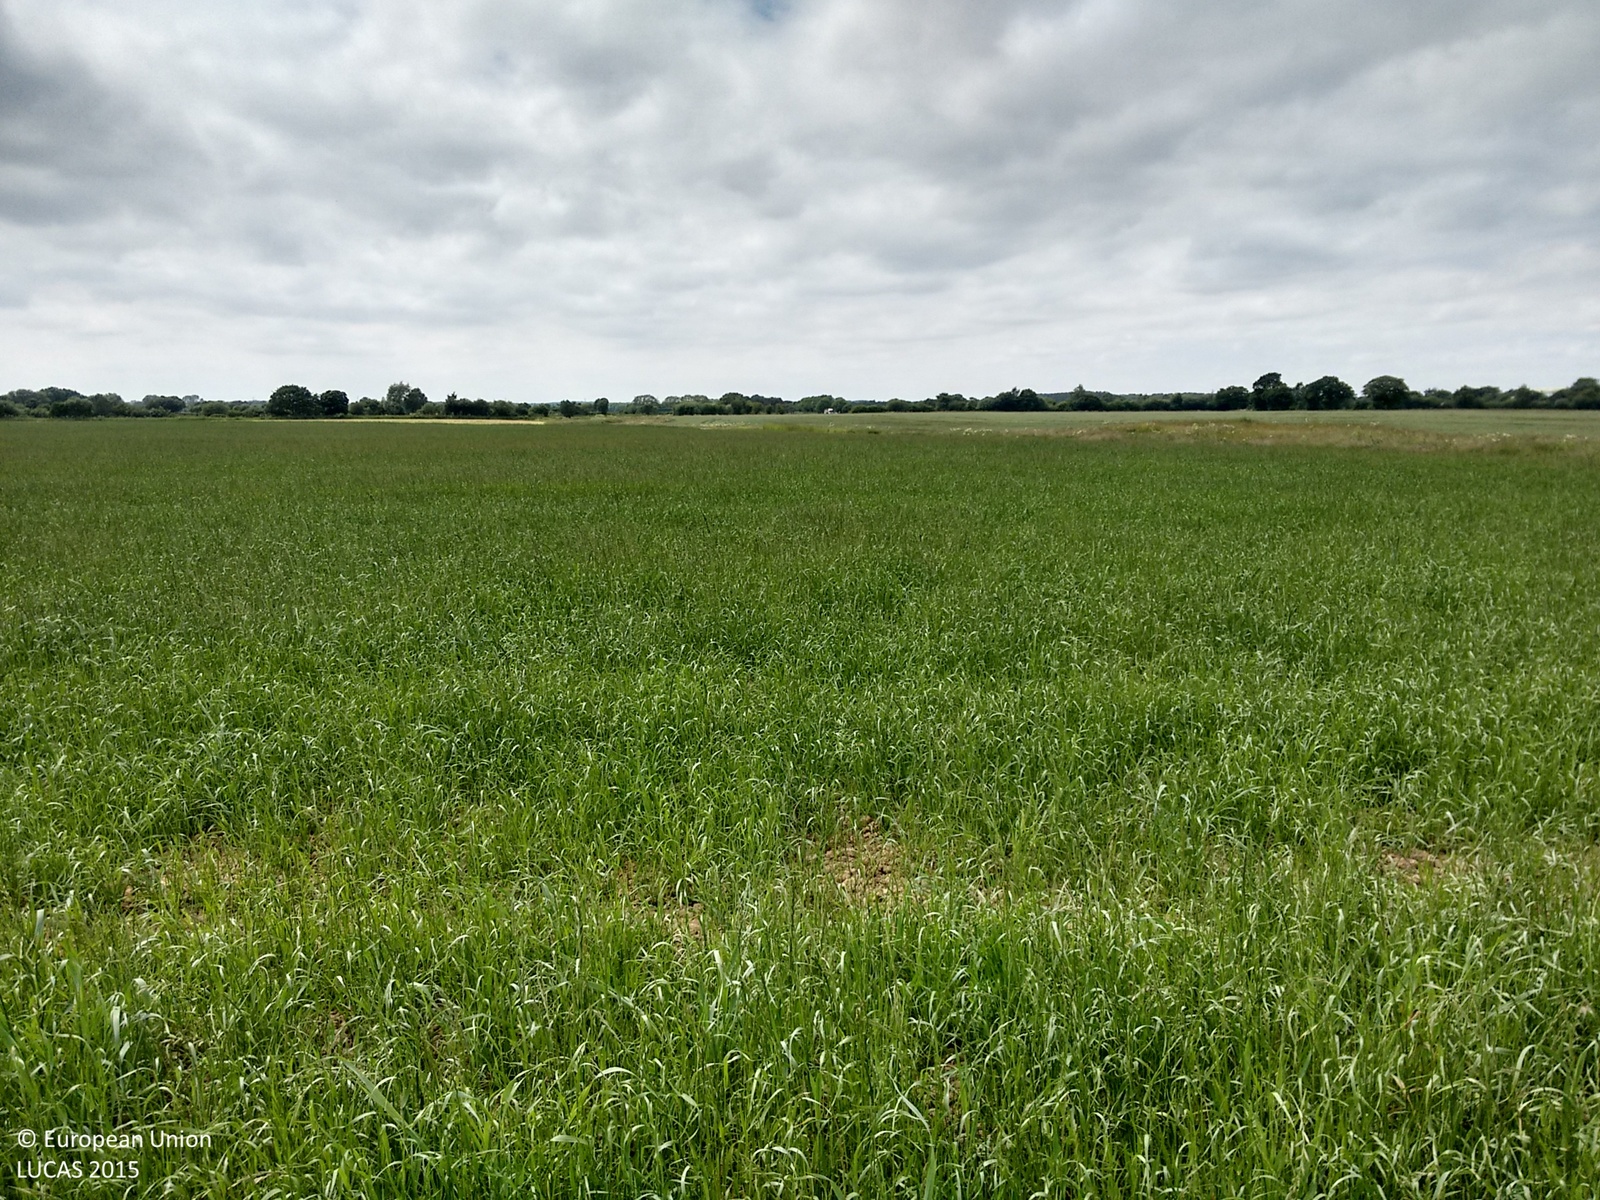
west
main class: Cropland
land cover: Barley
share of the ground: > 75 %
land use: Agriculture (excluding fallow land and kitchen gardens)
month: June
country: GB
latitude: 53.6493
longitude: -1.1342
